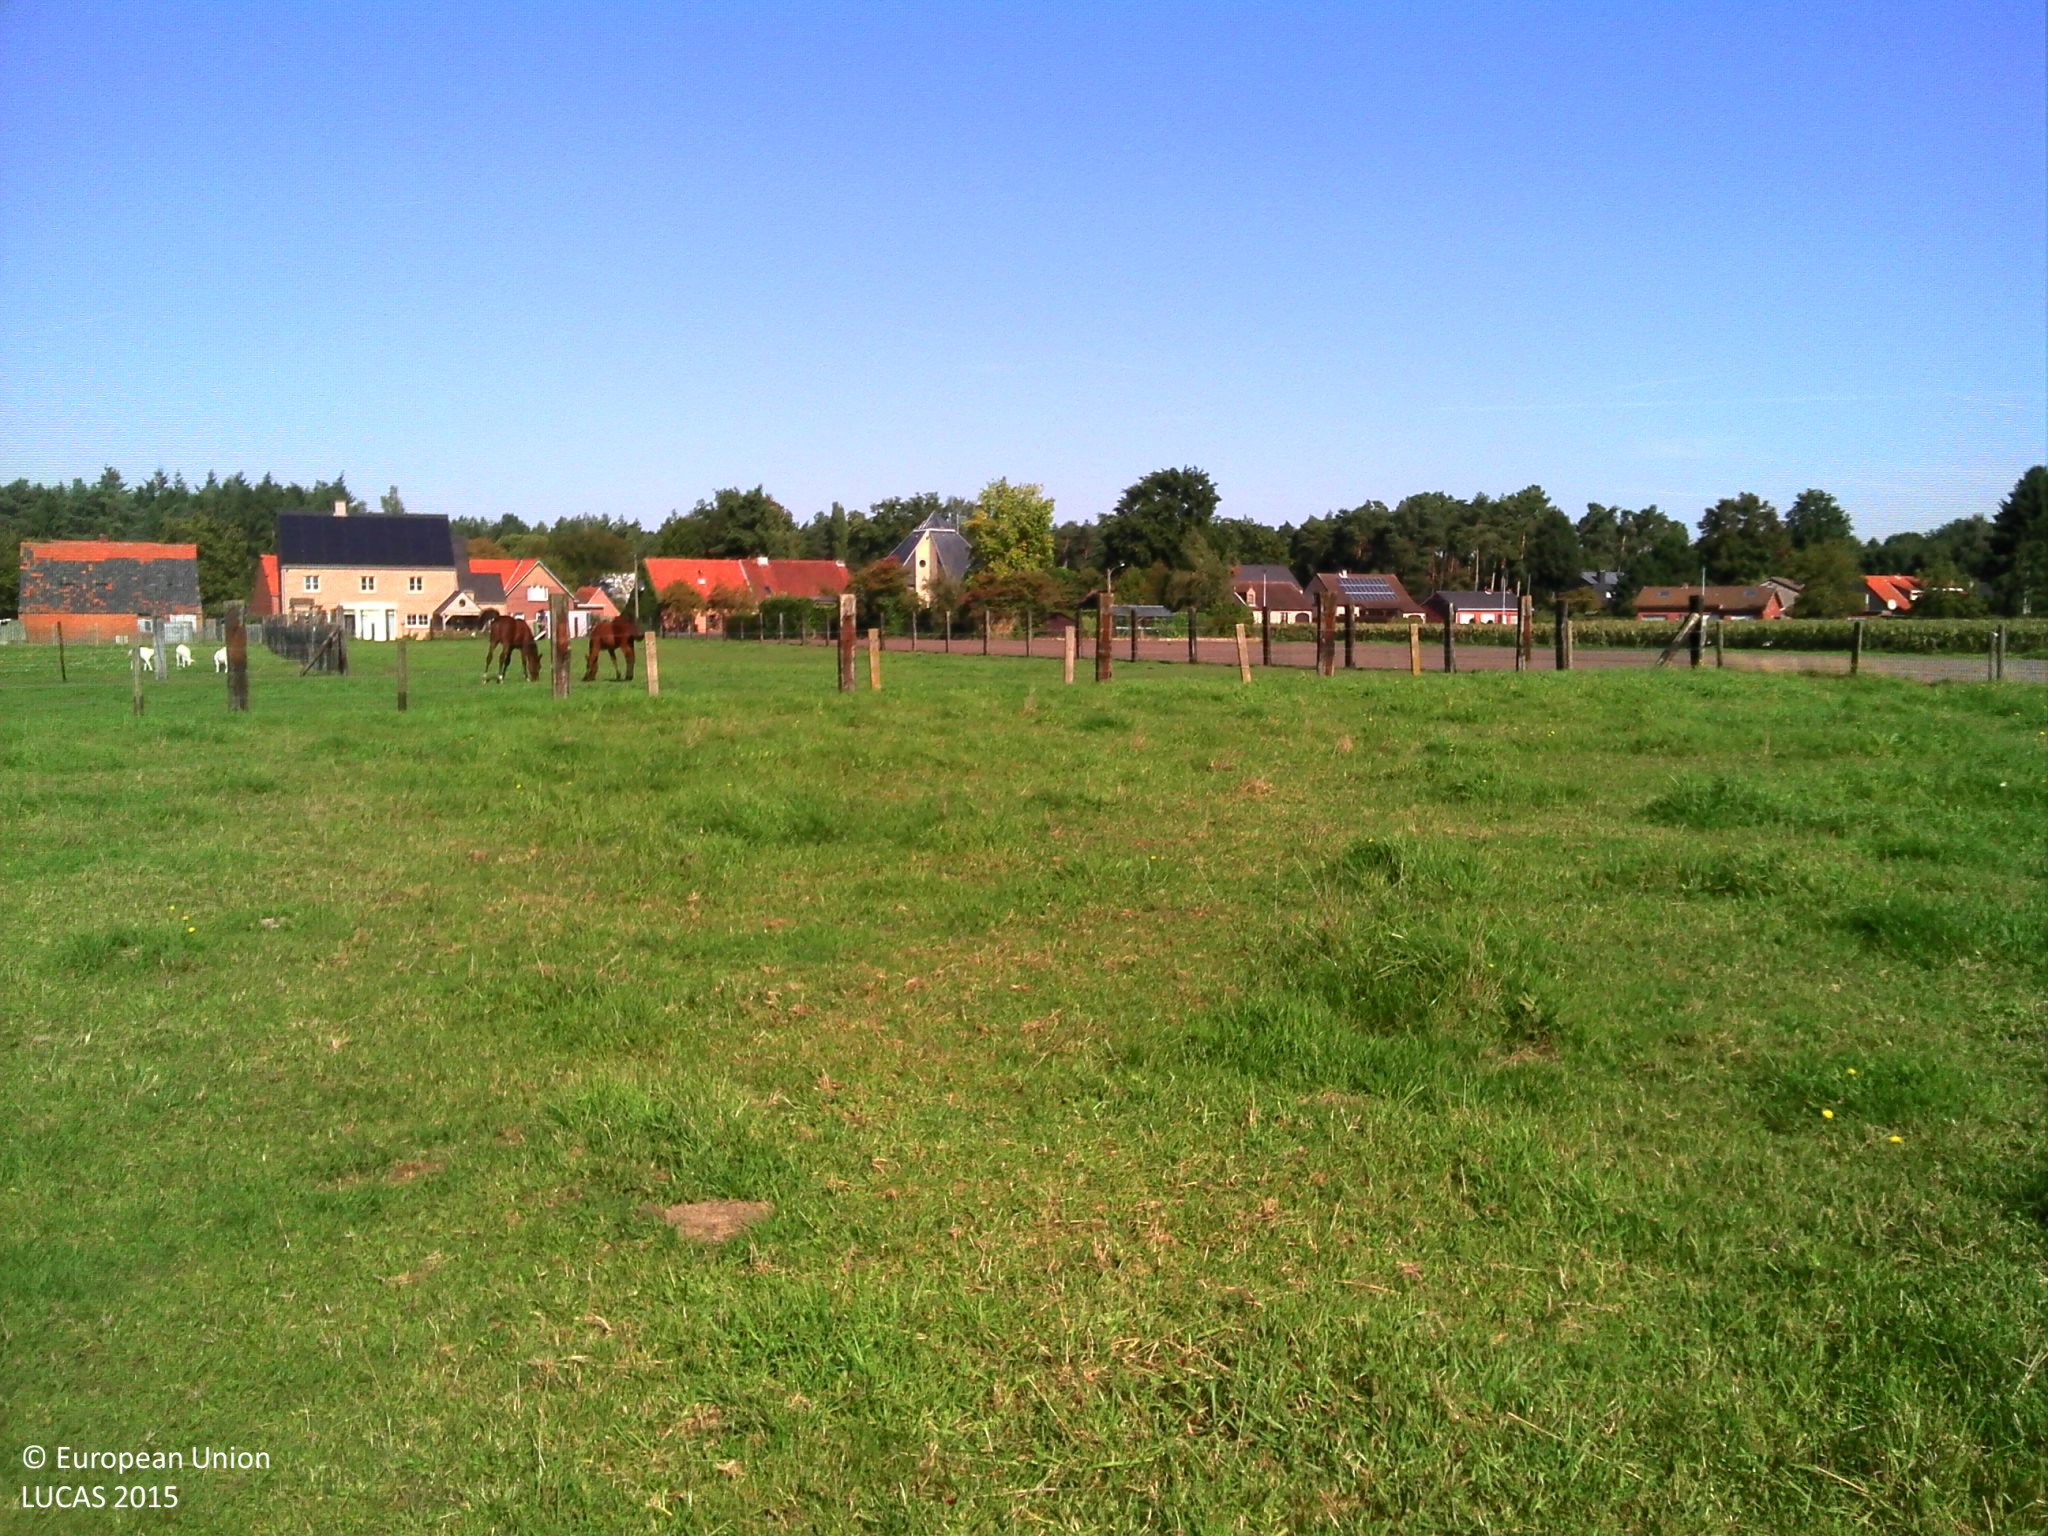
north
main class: Grassland
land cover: Grassland without tree/shrub cover
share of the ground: > 75 %
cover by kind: herbaceous plants 100 %
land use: Agriculture (excluding fallow land and kitchen gardens)
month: September
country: BE
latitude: 51.2546
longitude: 4.7953
